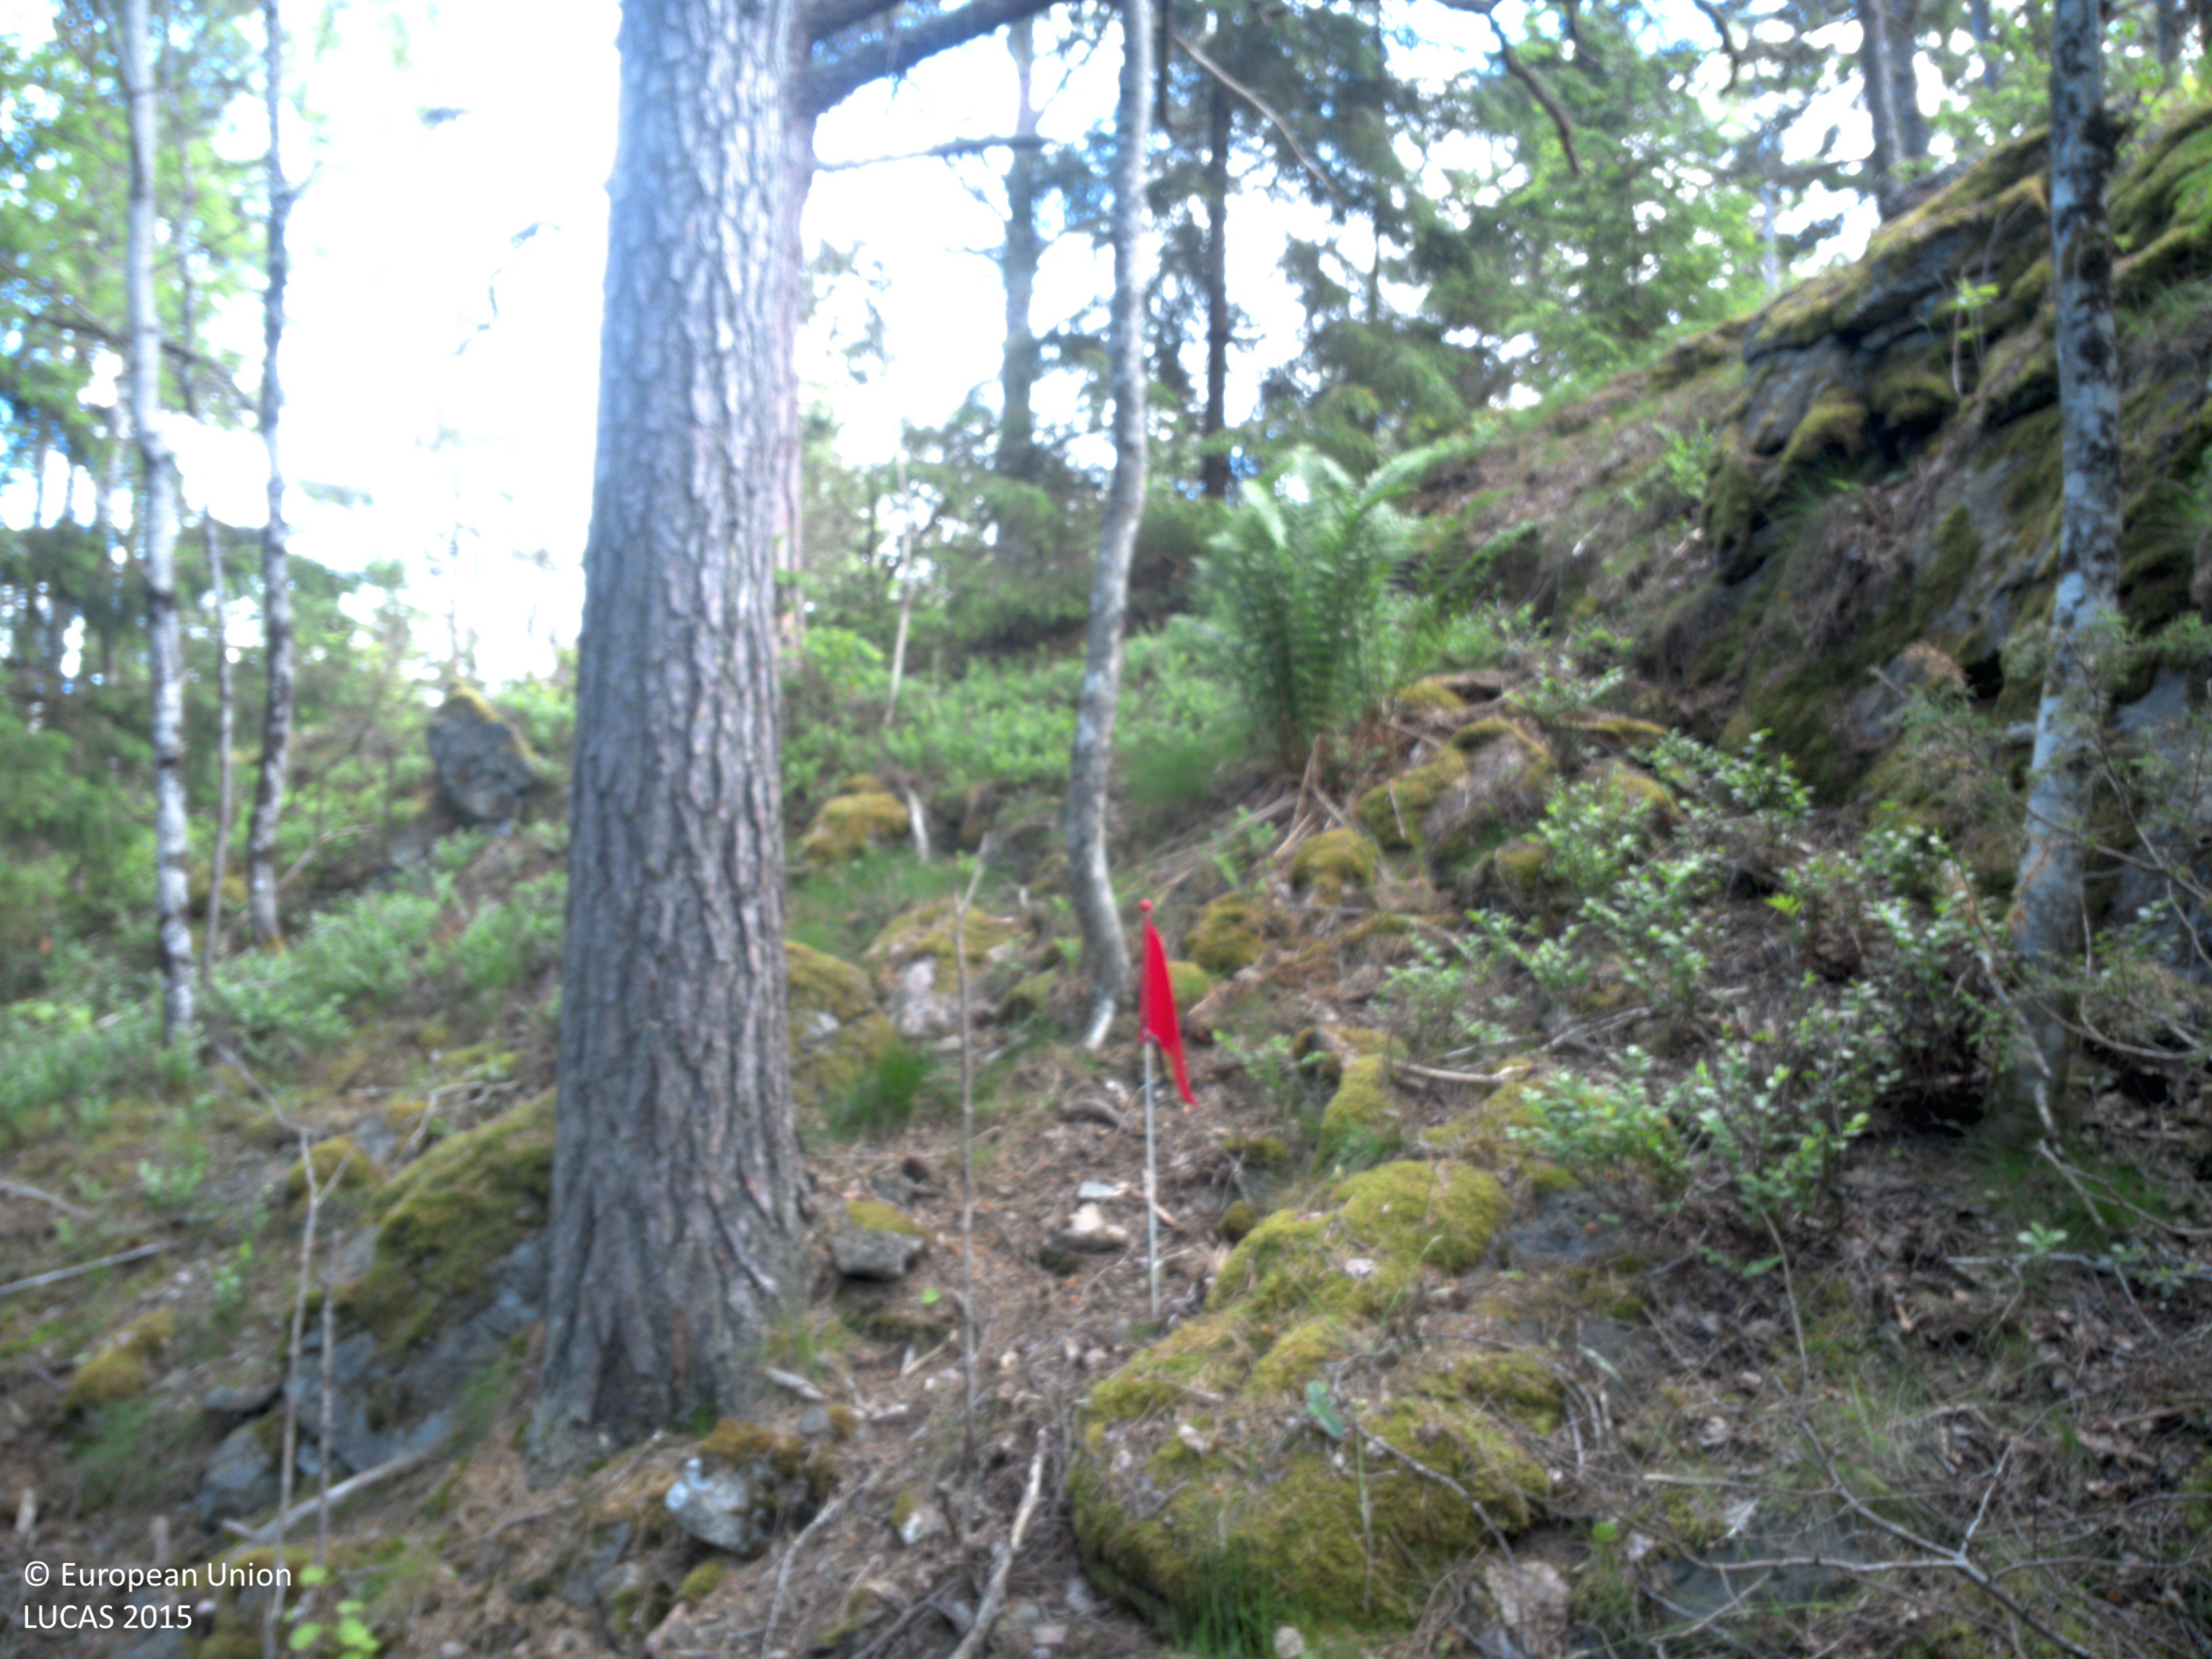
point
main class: Woodland
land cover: Other mixed woodland
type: boreal forest
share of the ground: 50 - 75 %
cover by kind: coniferous forest trees 30 %, broadleaved forest trees 25 %, herbaceous plants 15 %, lichens and mosses 15 %, consolidated bare surface 10 %, shrubs 5 %
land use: Forestry
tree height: > 5 m
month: June
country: SE
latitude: 58.9921
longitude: 12.2746
